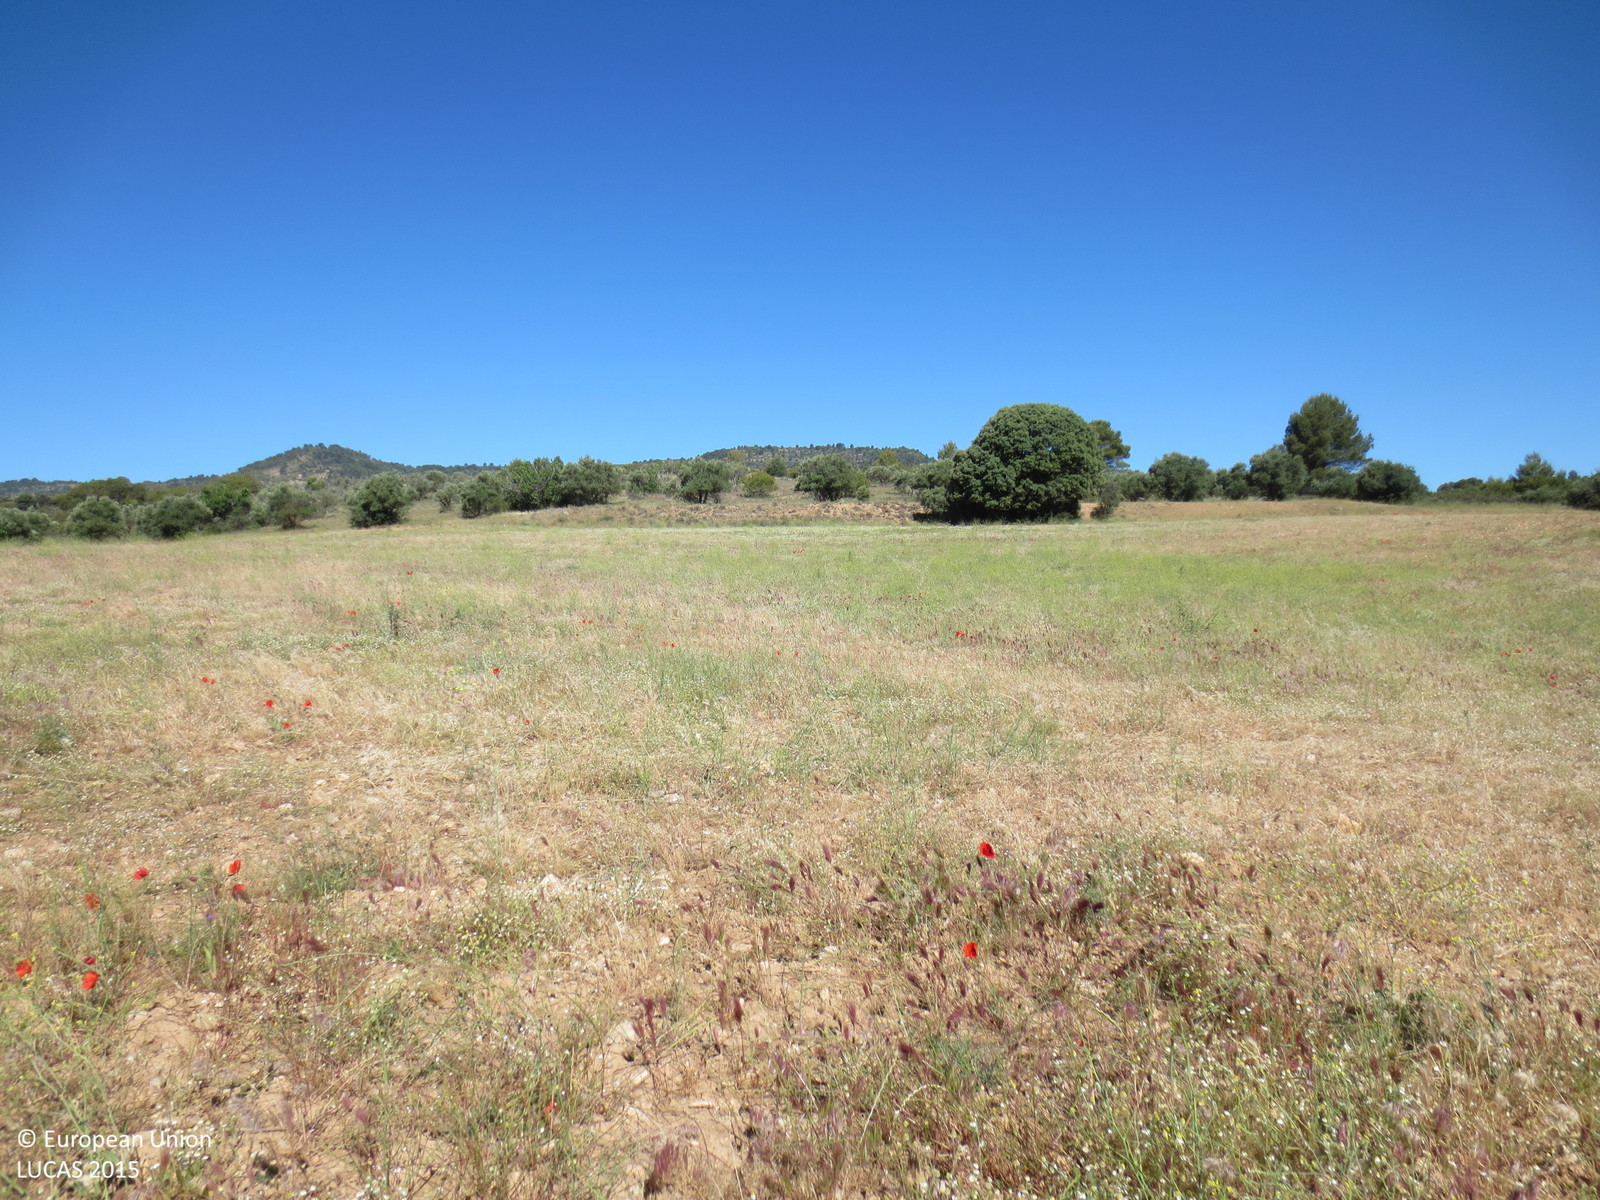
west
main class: Grassland
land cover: Spontaneously vegetated surfaces
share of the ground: 50 - 75 %
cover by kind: herbaceous plants 60 %, unconsolidated bare surface 40 %
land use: Fallow land
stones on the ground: > 50 %
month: May
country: ES
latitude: 40.4885
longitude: -2.7806
